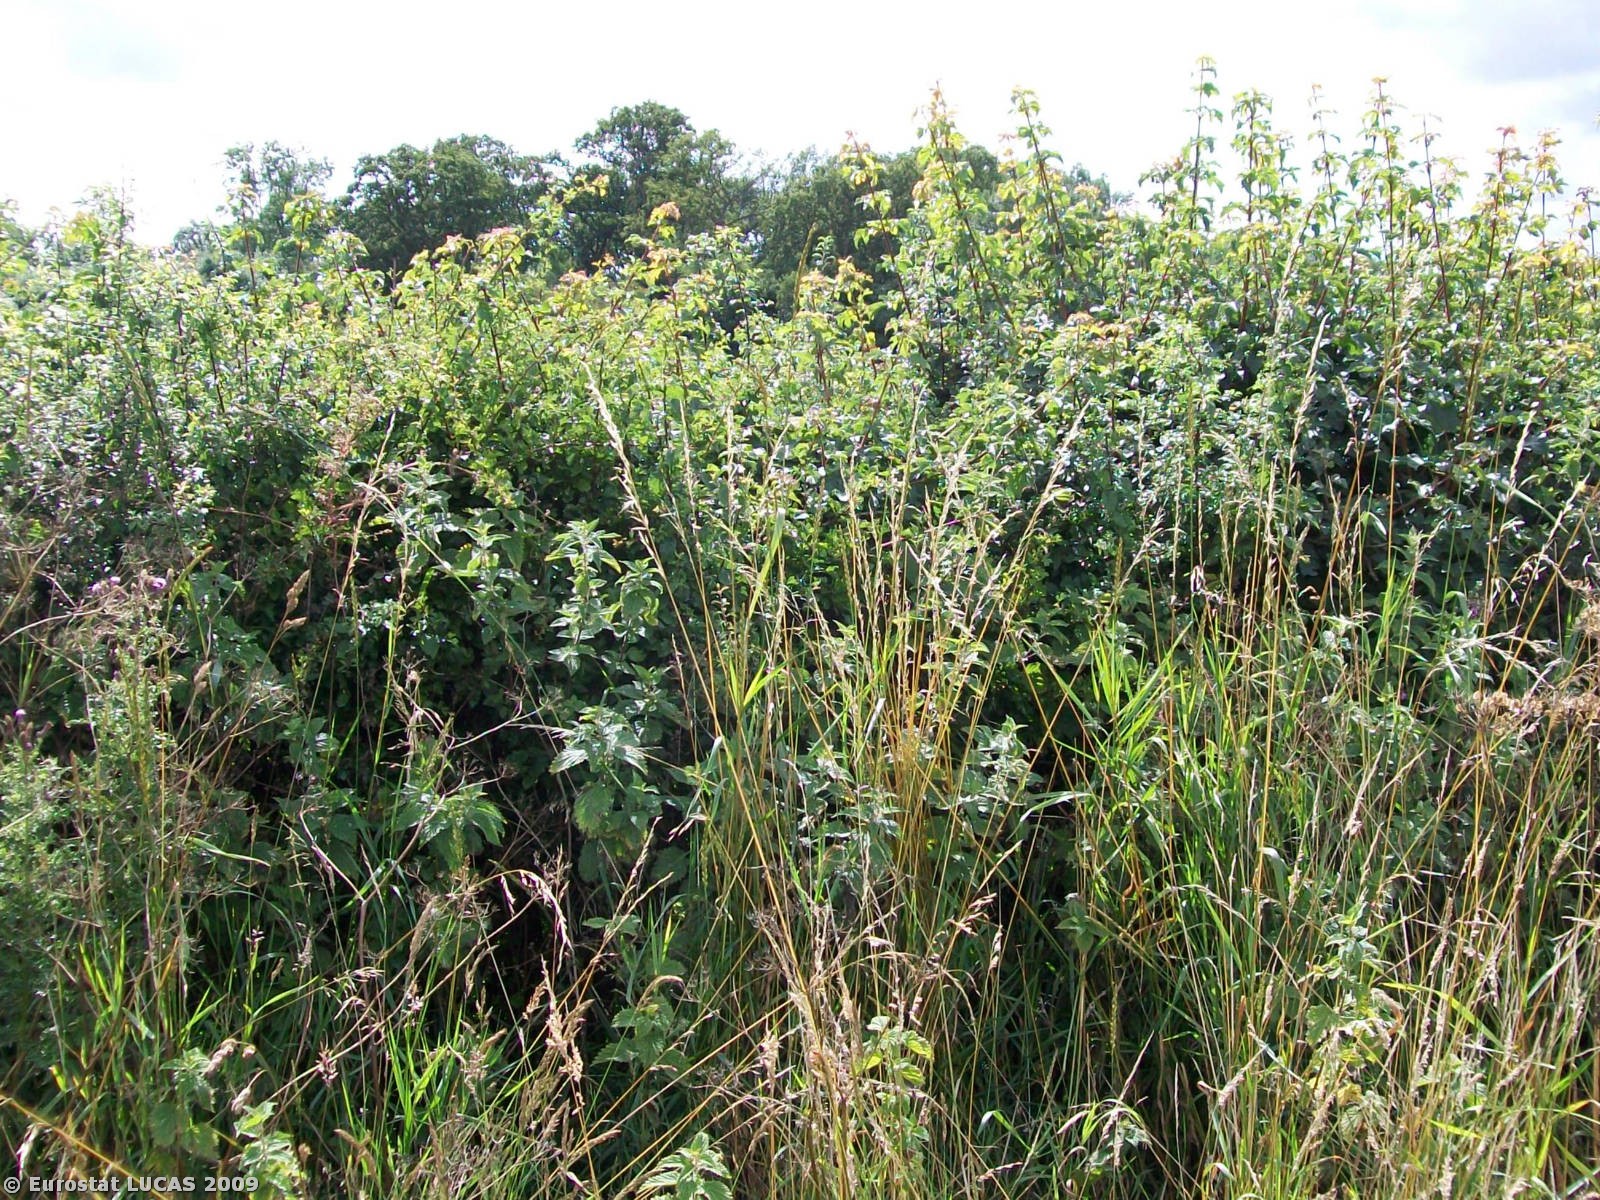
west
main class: Grassland
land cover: Grassland without tree/shrub cover
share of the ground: > 75 %
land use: Agriculture (excluding fallow land and kitchen gardens)
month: July
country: GB
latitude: 51.5020
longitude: -2.2646
